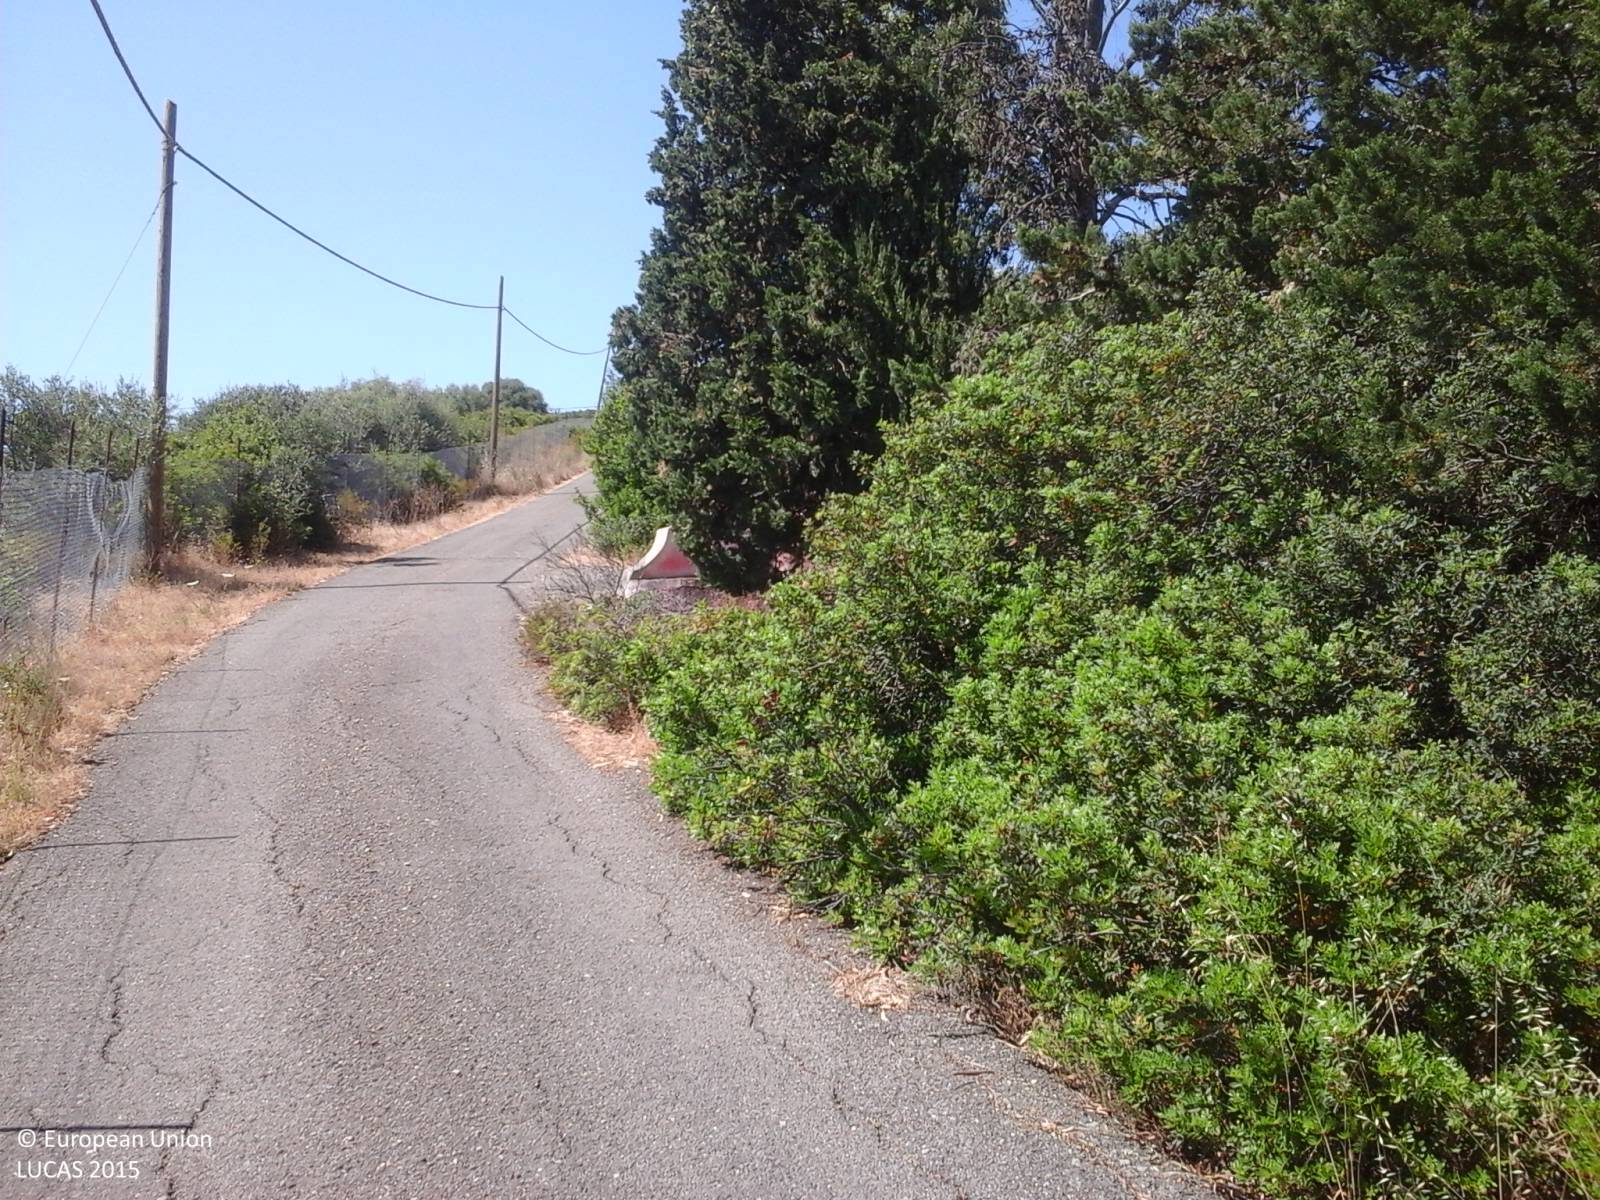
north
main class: Shrubland
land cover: Shrubland with sparse tree cover
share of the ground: > 75 %
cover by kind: herbaceous plants 70 %, shrubs 25 %, broadleaved forest trees 5 %
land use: Semi-natural and natural areas not in use
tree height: > 5 m
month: June
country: IT
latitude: 39.2688
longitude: 9.3204
